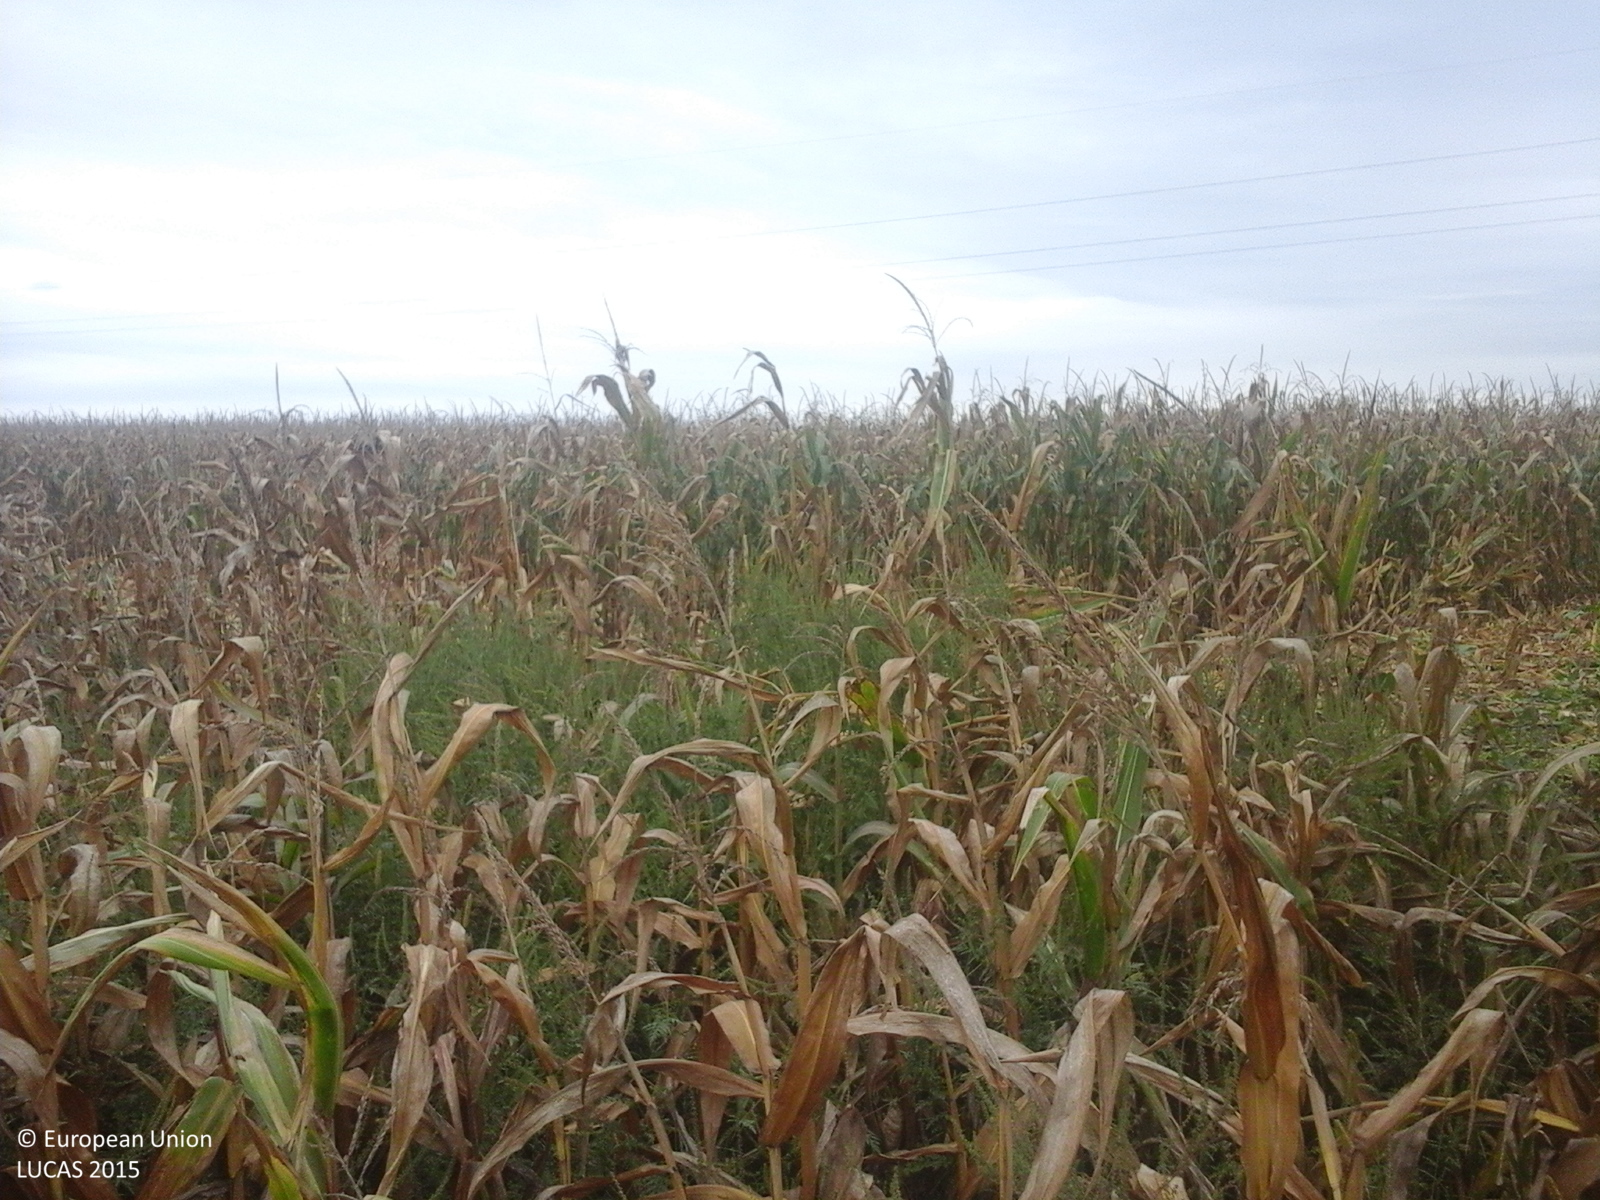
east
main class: Cropland
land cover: Maize
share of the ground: > 75 %
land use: Agriculture (excluding fallow land and kitchen gardens)
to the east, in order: Maize; Electric lines; Maize; Grassland without tree/shrub cover
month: September
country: RO
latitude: 47.3143
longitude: 21.9673
